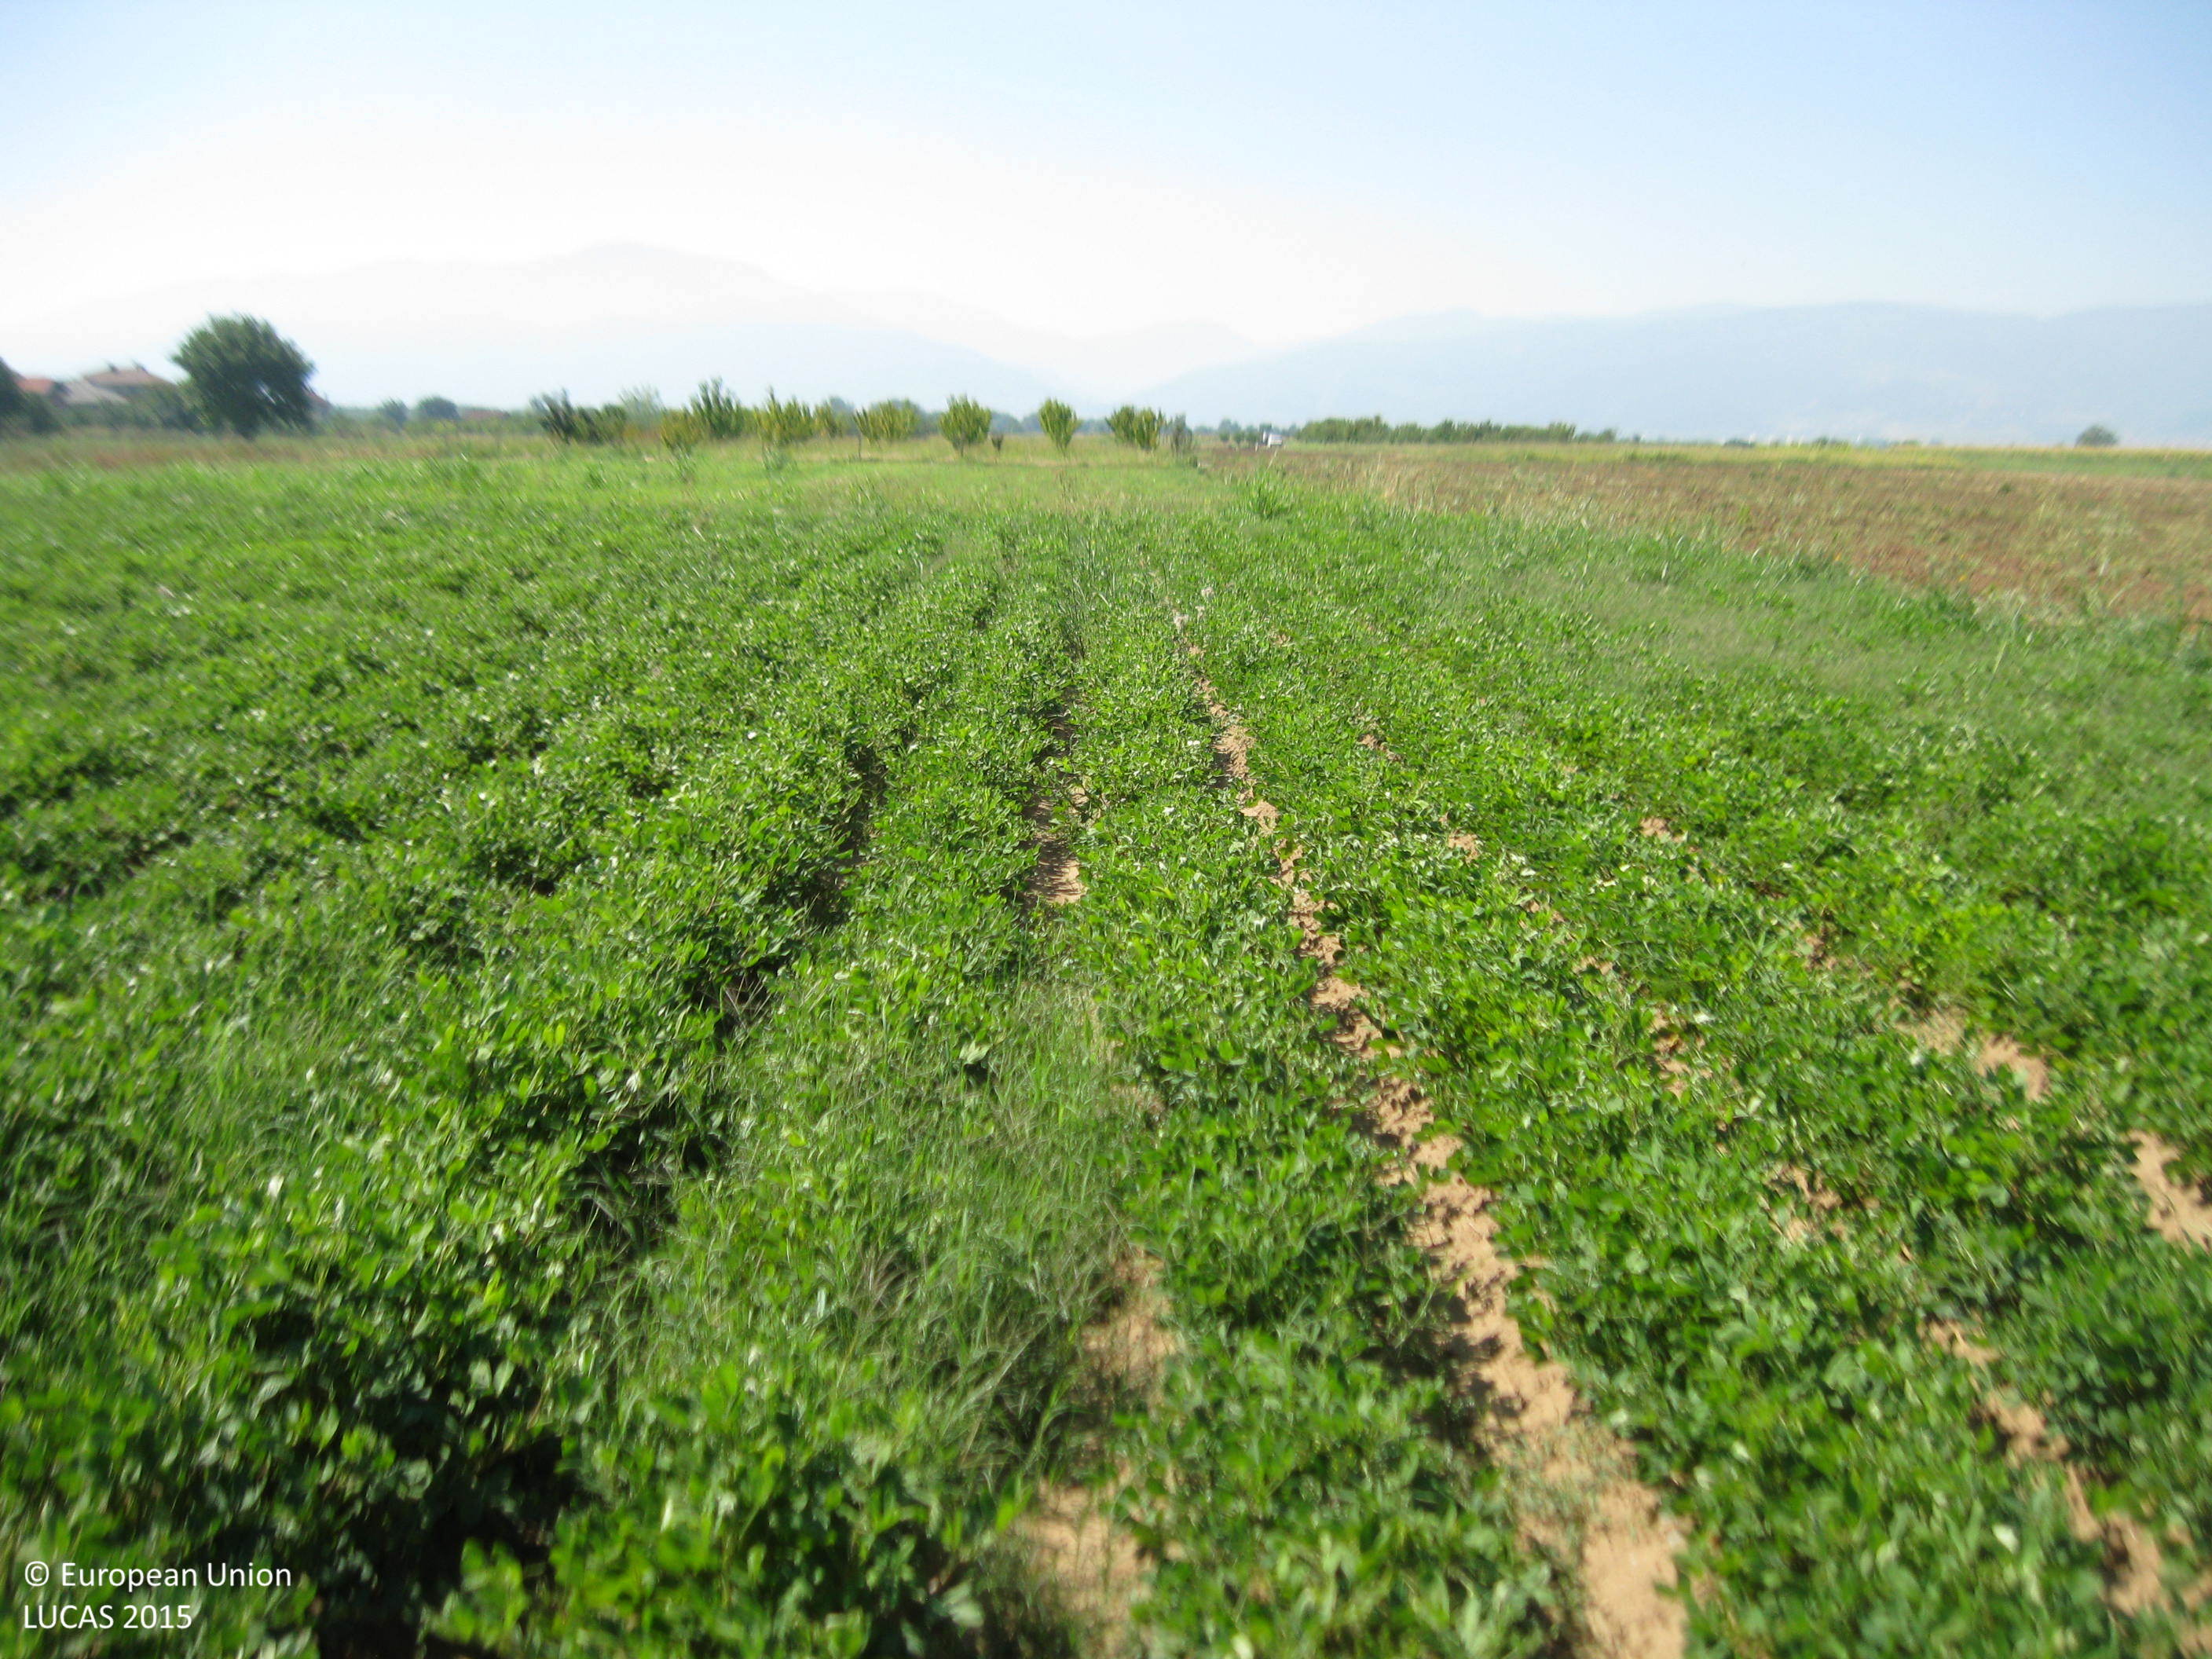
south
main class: Cropland
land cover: Soya
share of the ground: > 75 %
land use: Agriculture (excluding fallow land and kitchen gardens)
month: September
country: BG
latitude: 42.0752
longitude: 24.9085
